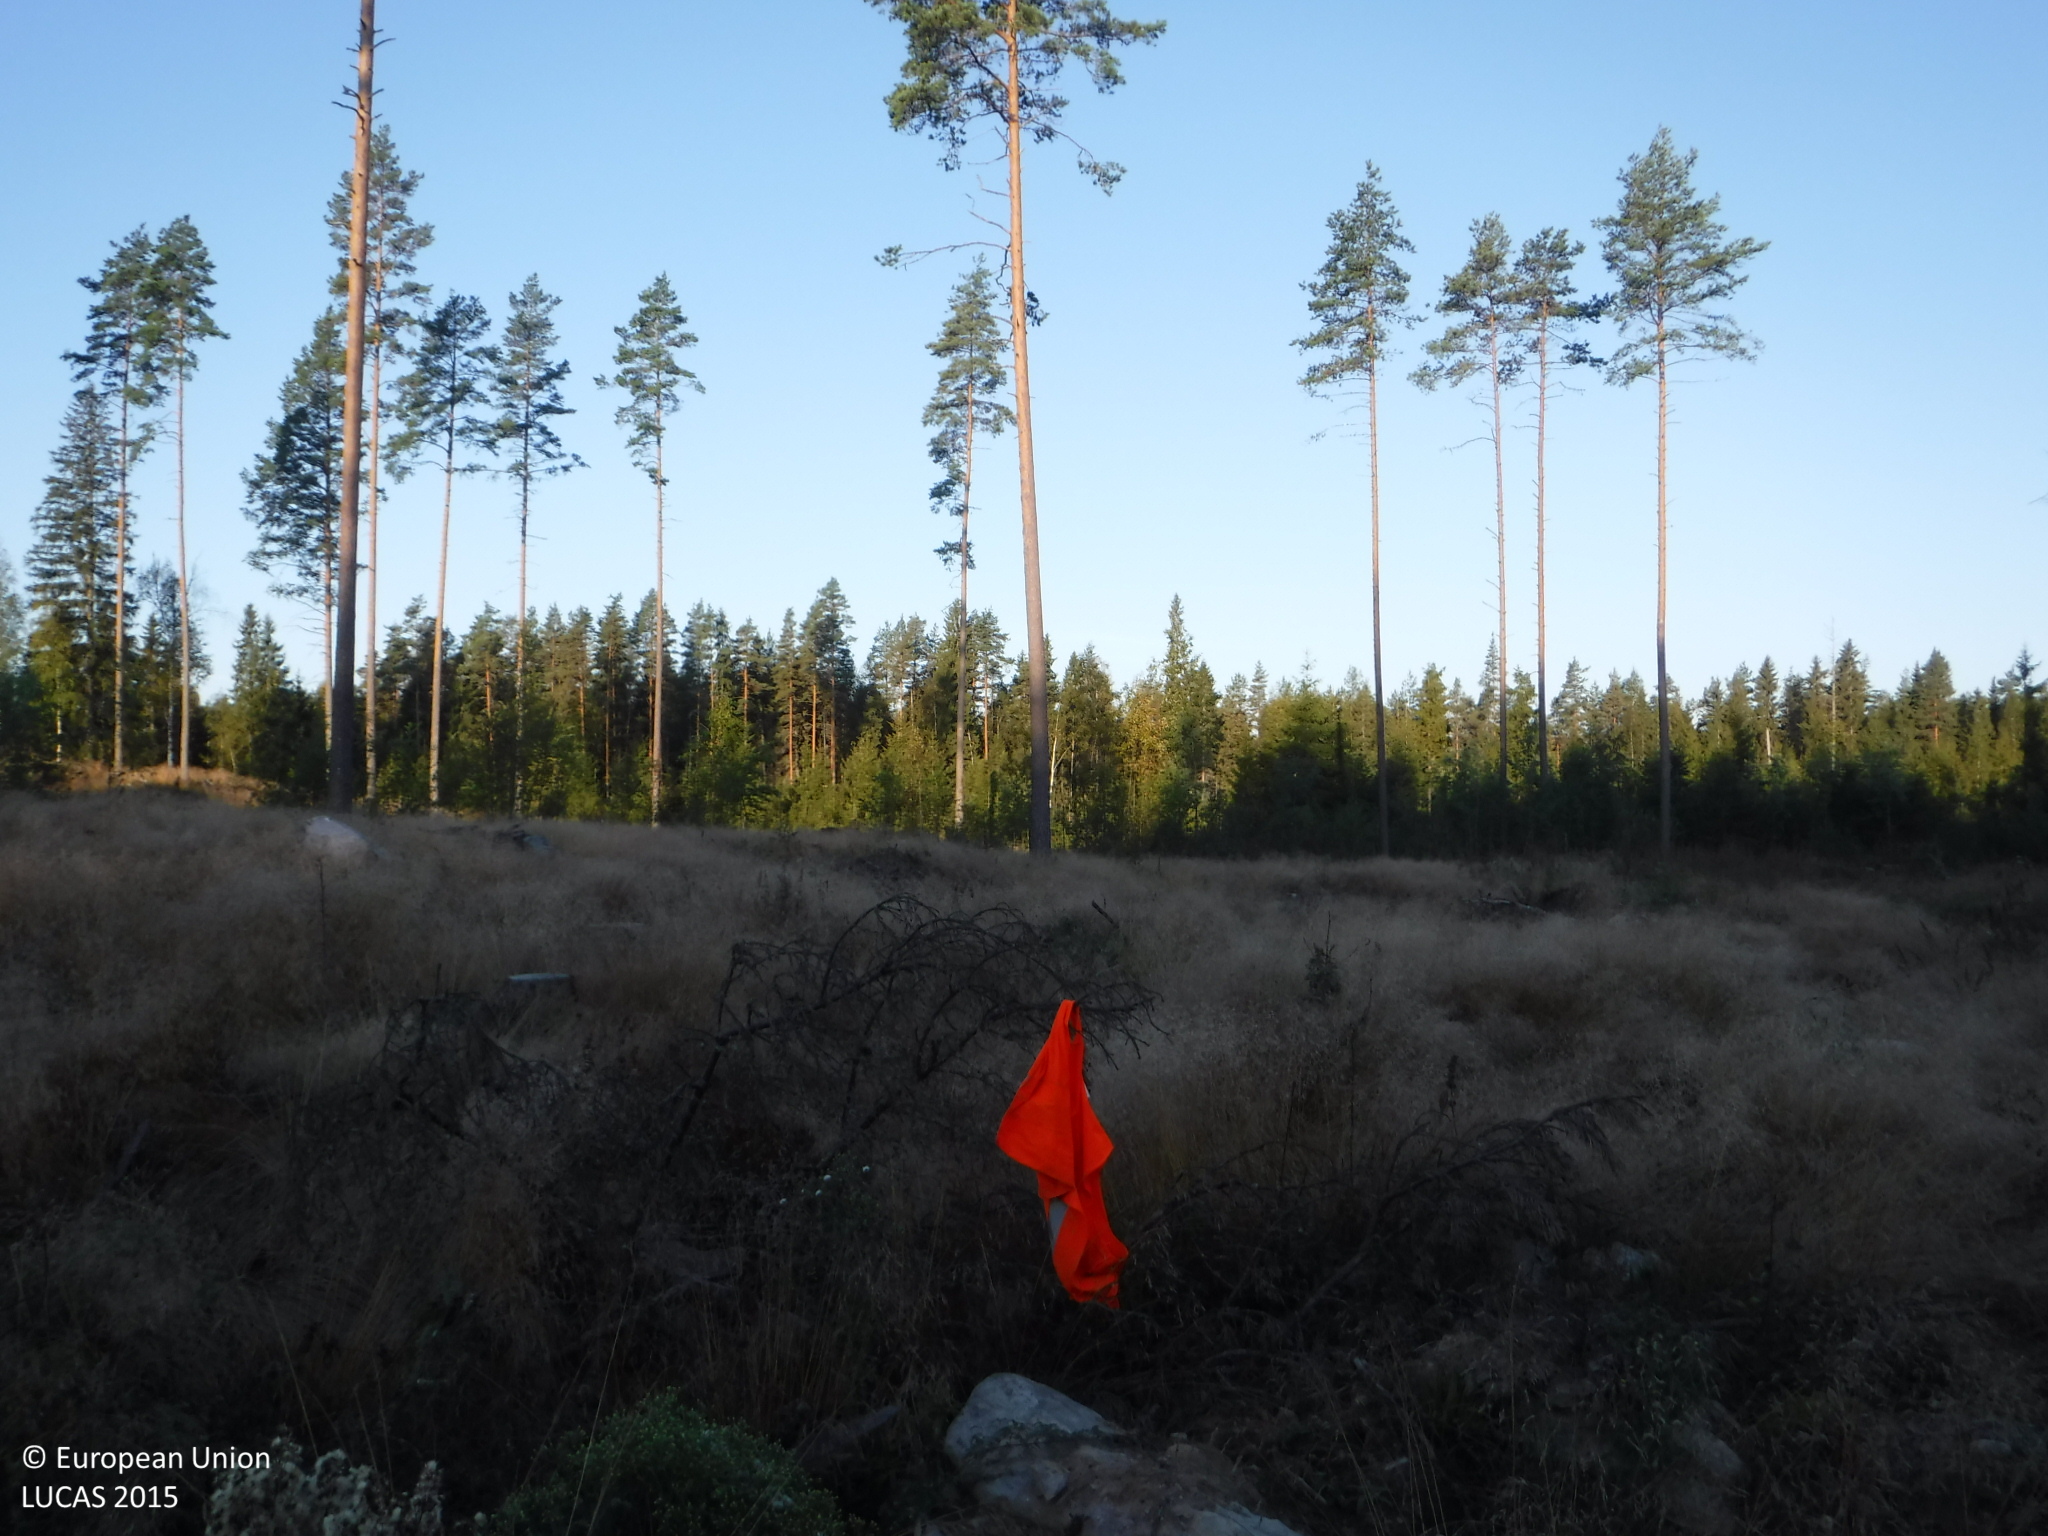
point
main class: Grassland
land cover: Spontaneously vegetated surfaces
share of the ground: 50 - 75 %
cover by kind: herbaceous plants 70 %, unconsolidated bare surface 25 %, consolidated bare surface 5 %
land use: Forestry
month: September
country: FI
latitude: 61.7110
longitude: 22.6424
